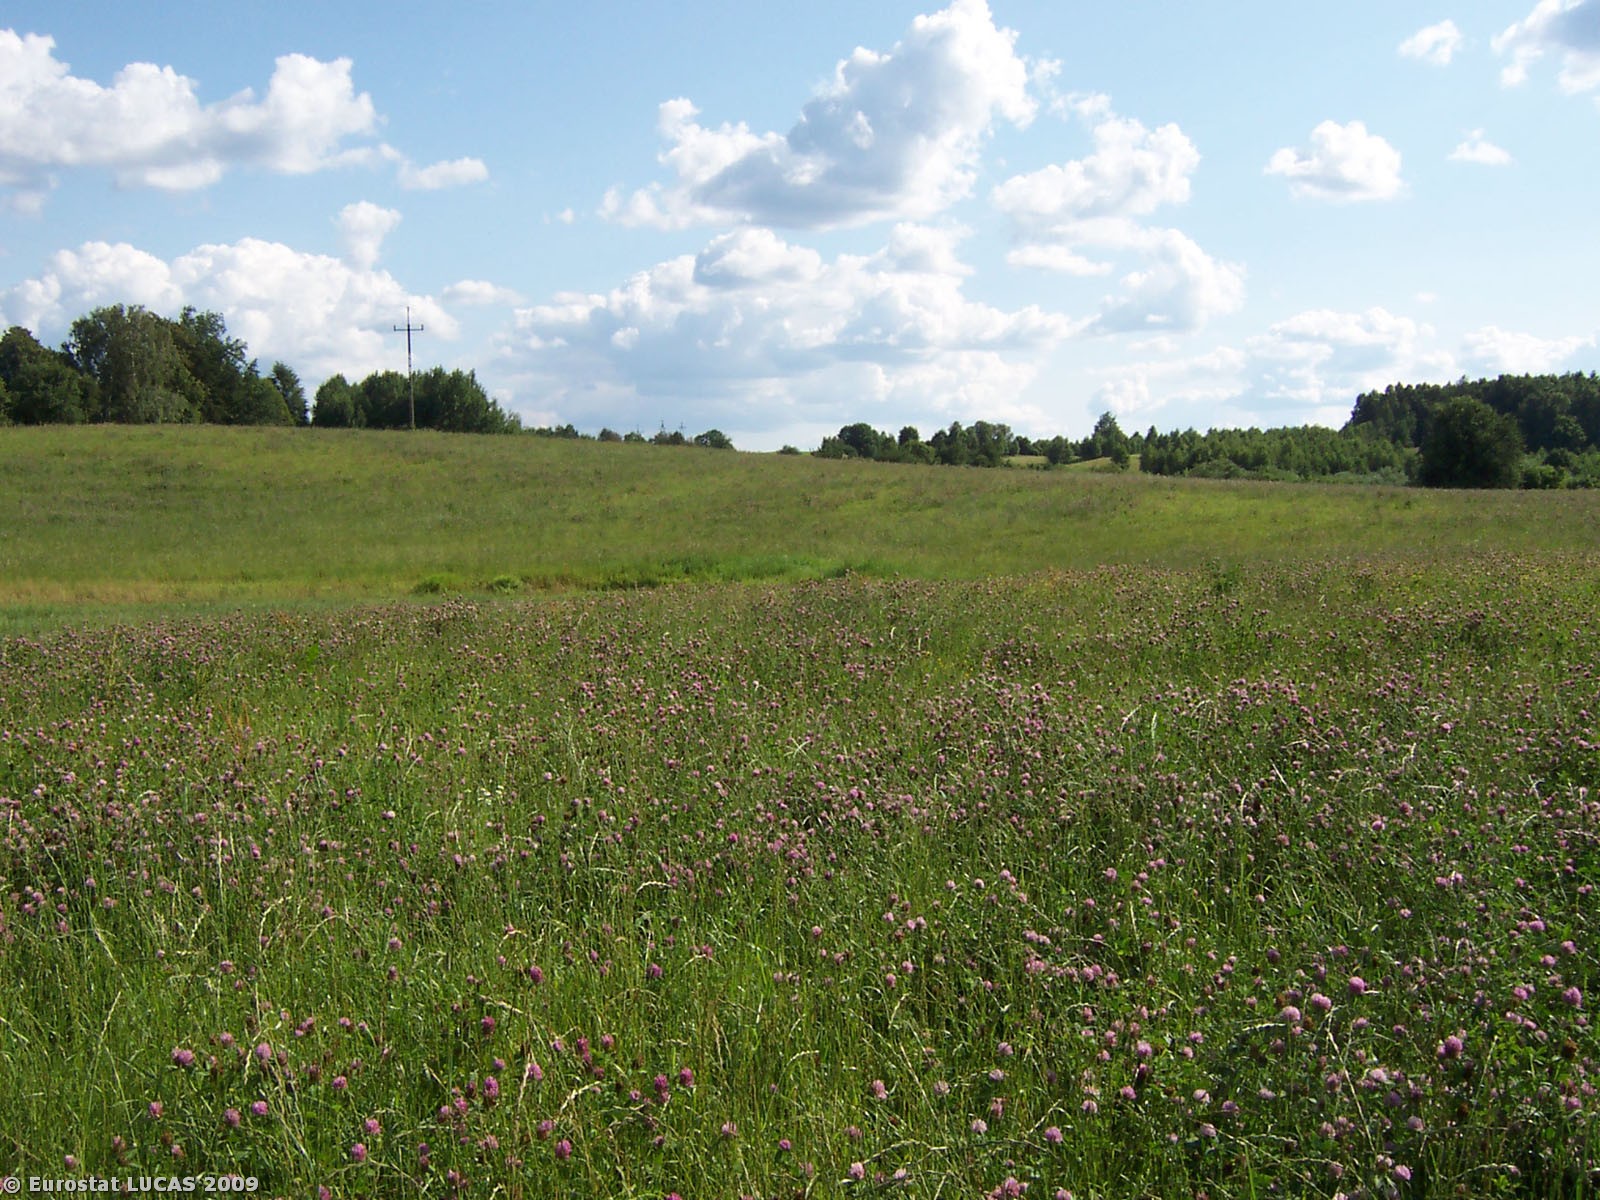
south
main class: Cropland
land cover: Clovers
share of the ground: > 75 %
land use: Agriculture (excluding fallow land and kitchen gardens)
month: August
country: PL
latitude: 53.7257
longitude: 21.0931
